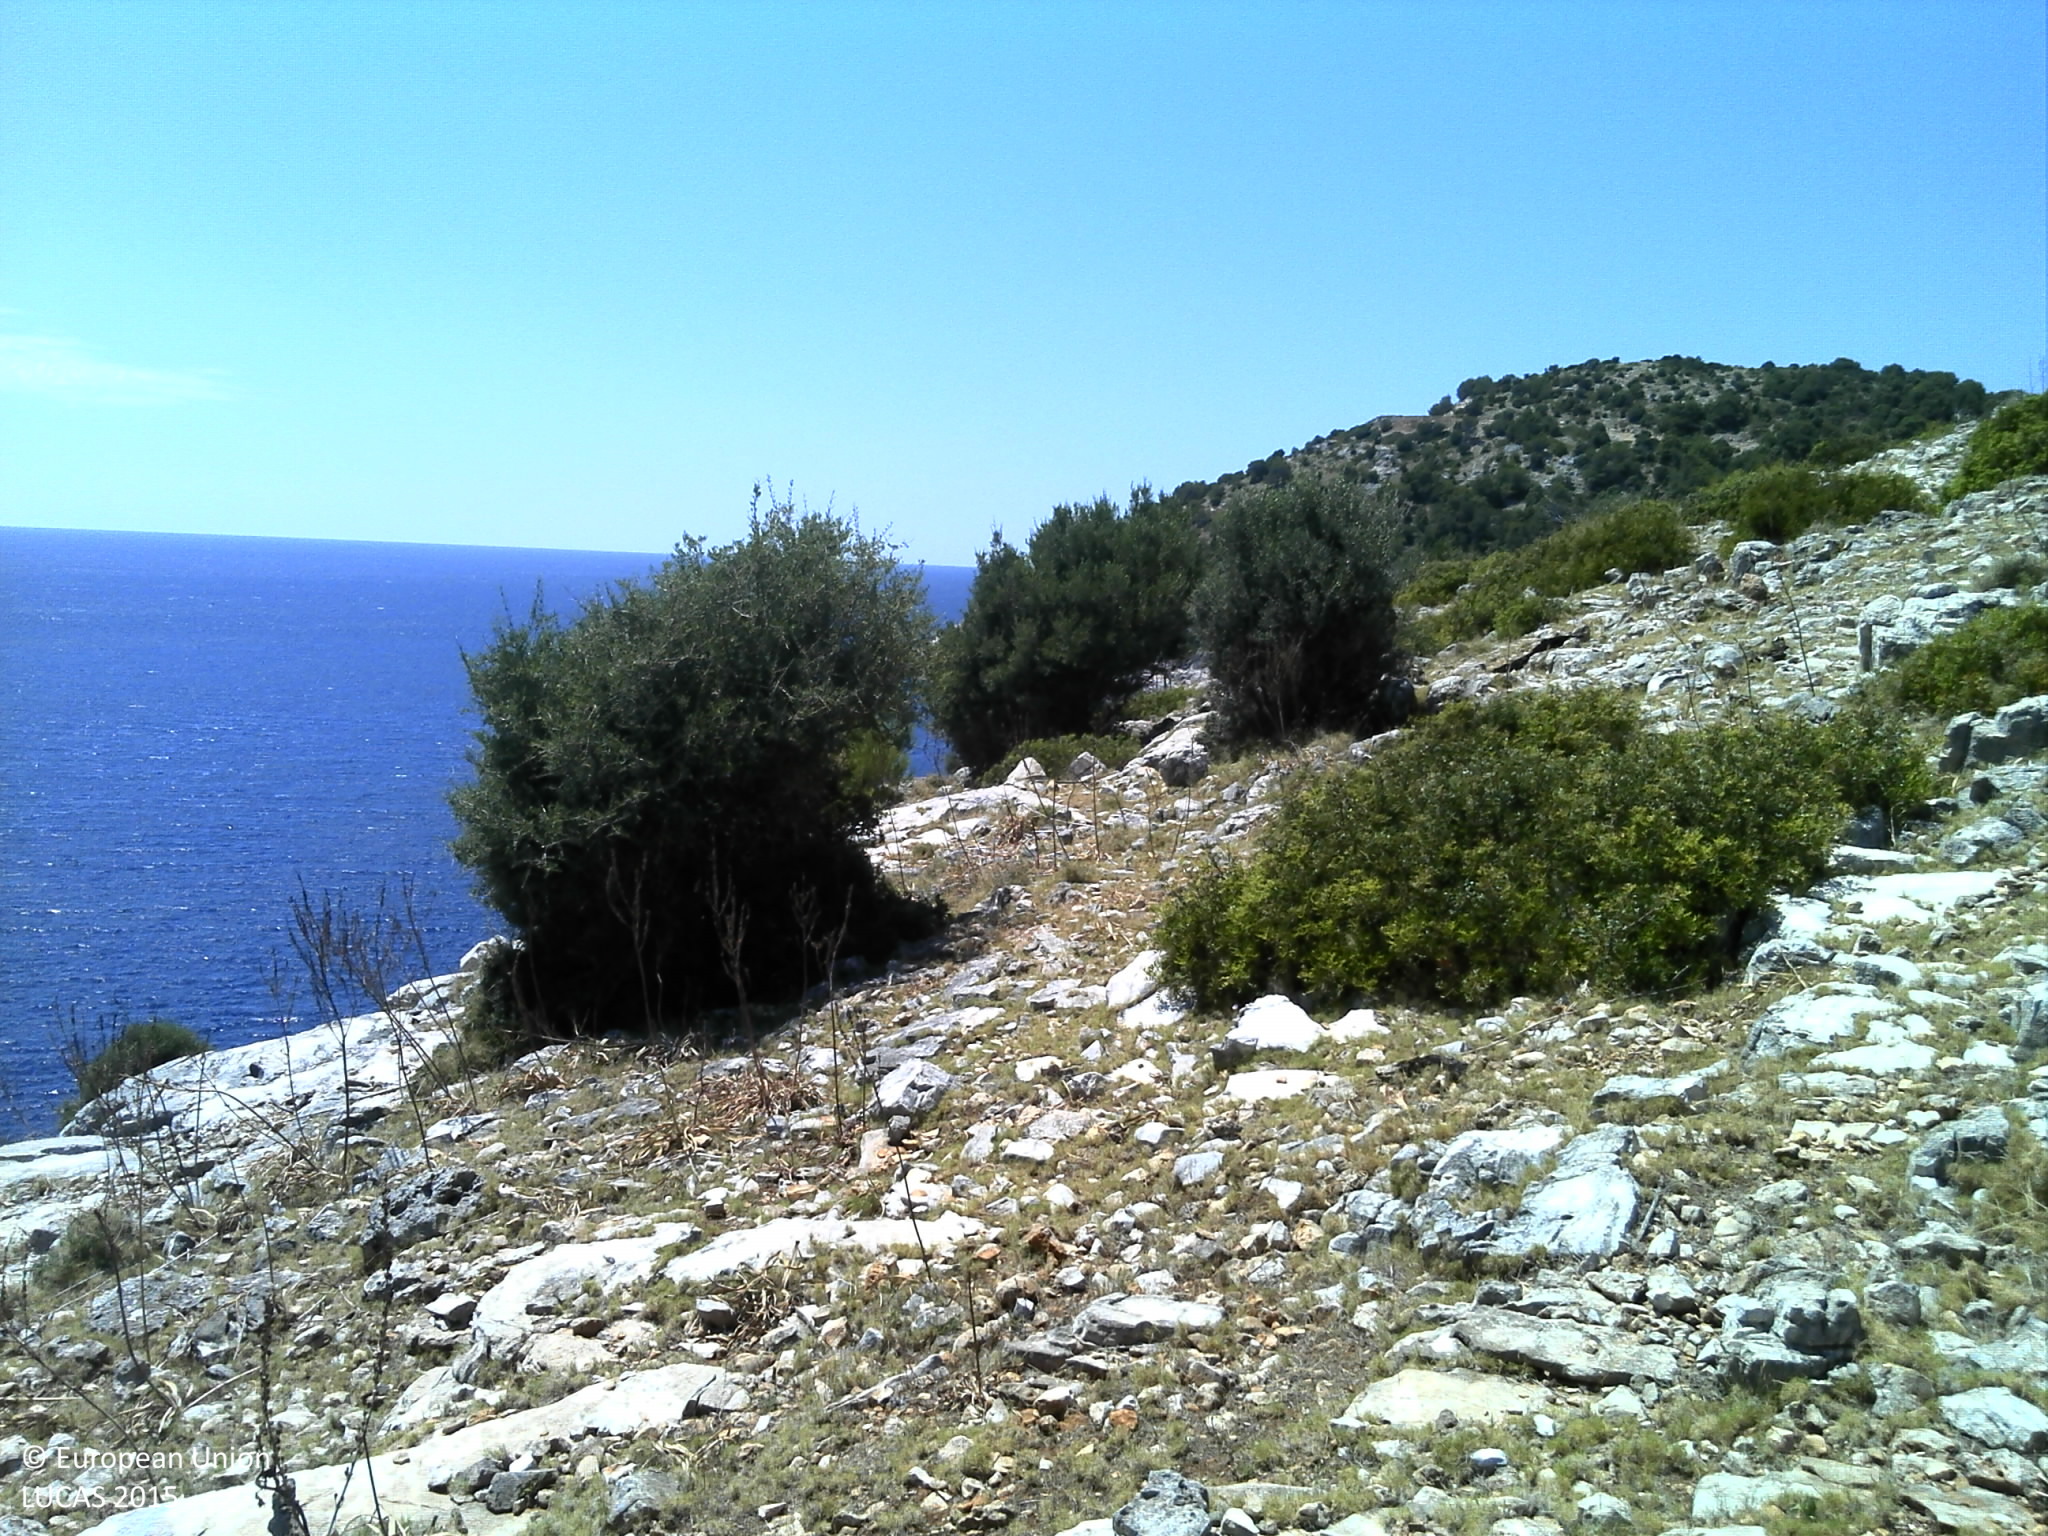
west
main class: Shrubland
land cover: Shrubland without tree cover
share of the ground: 50 - 75 %
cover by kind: shrubs 50 %, unconsolidated bare surface 25 %, consolidated bare surface 15 %, herbaceous plants 10 %
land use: Semi-natural and natural areas not in use
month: June
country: HR
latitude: 42.7307
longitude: 16.8396
